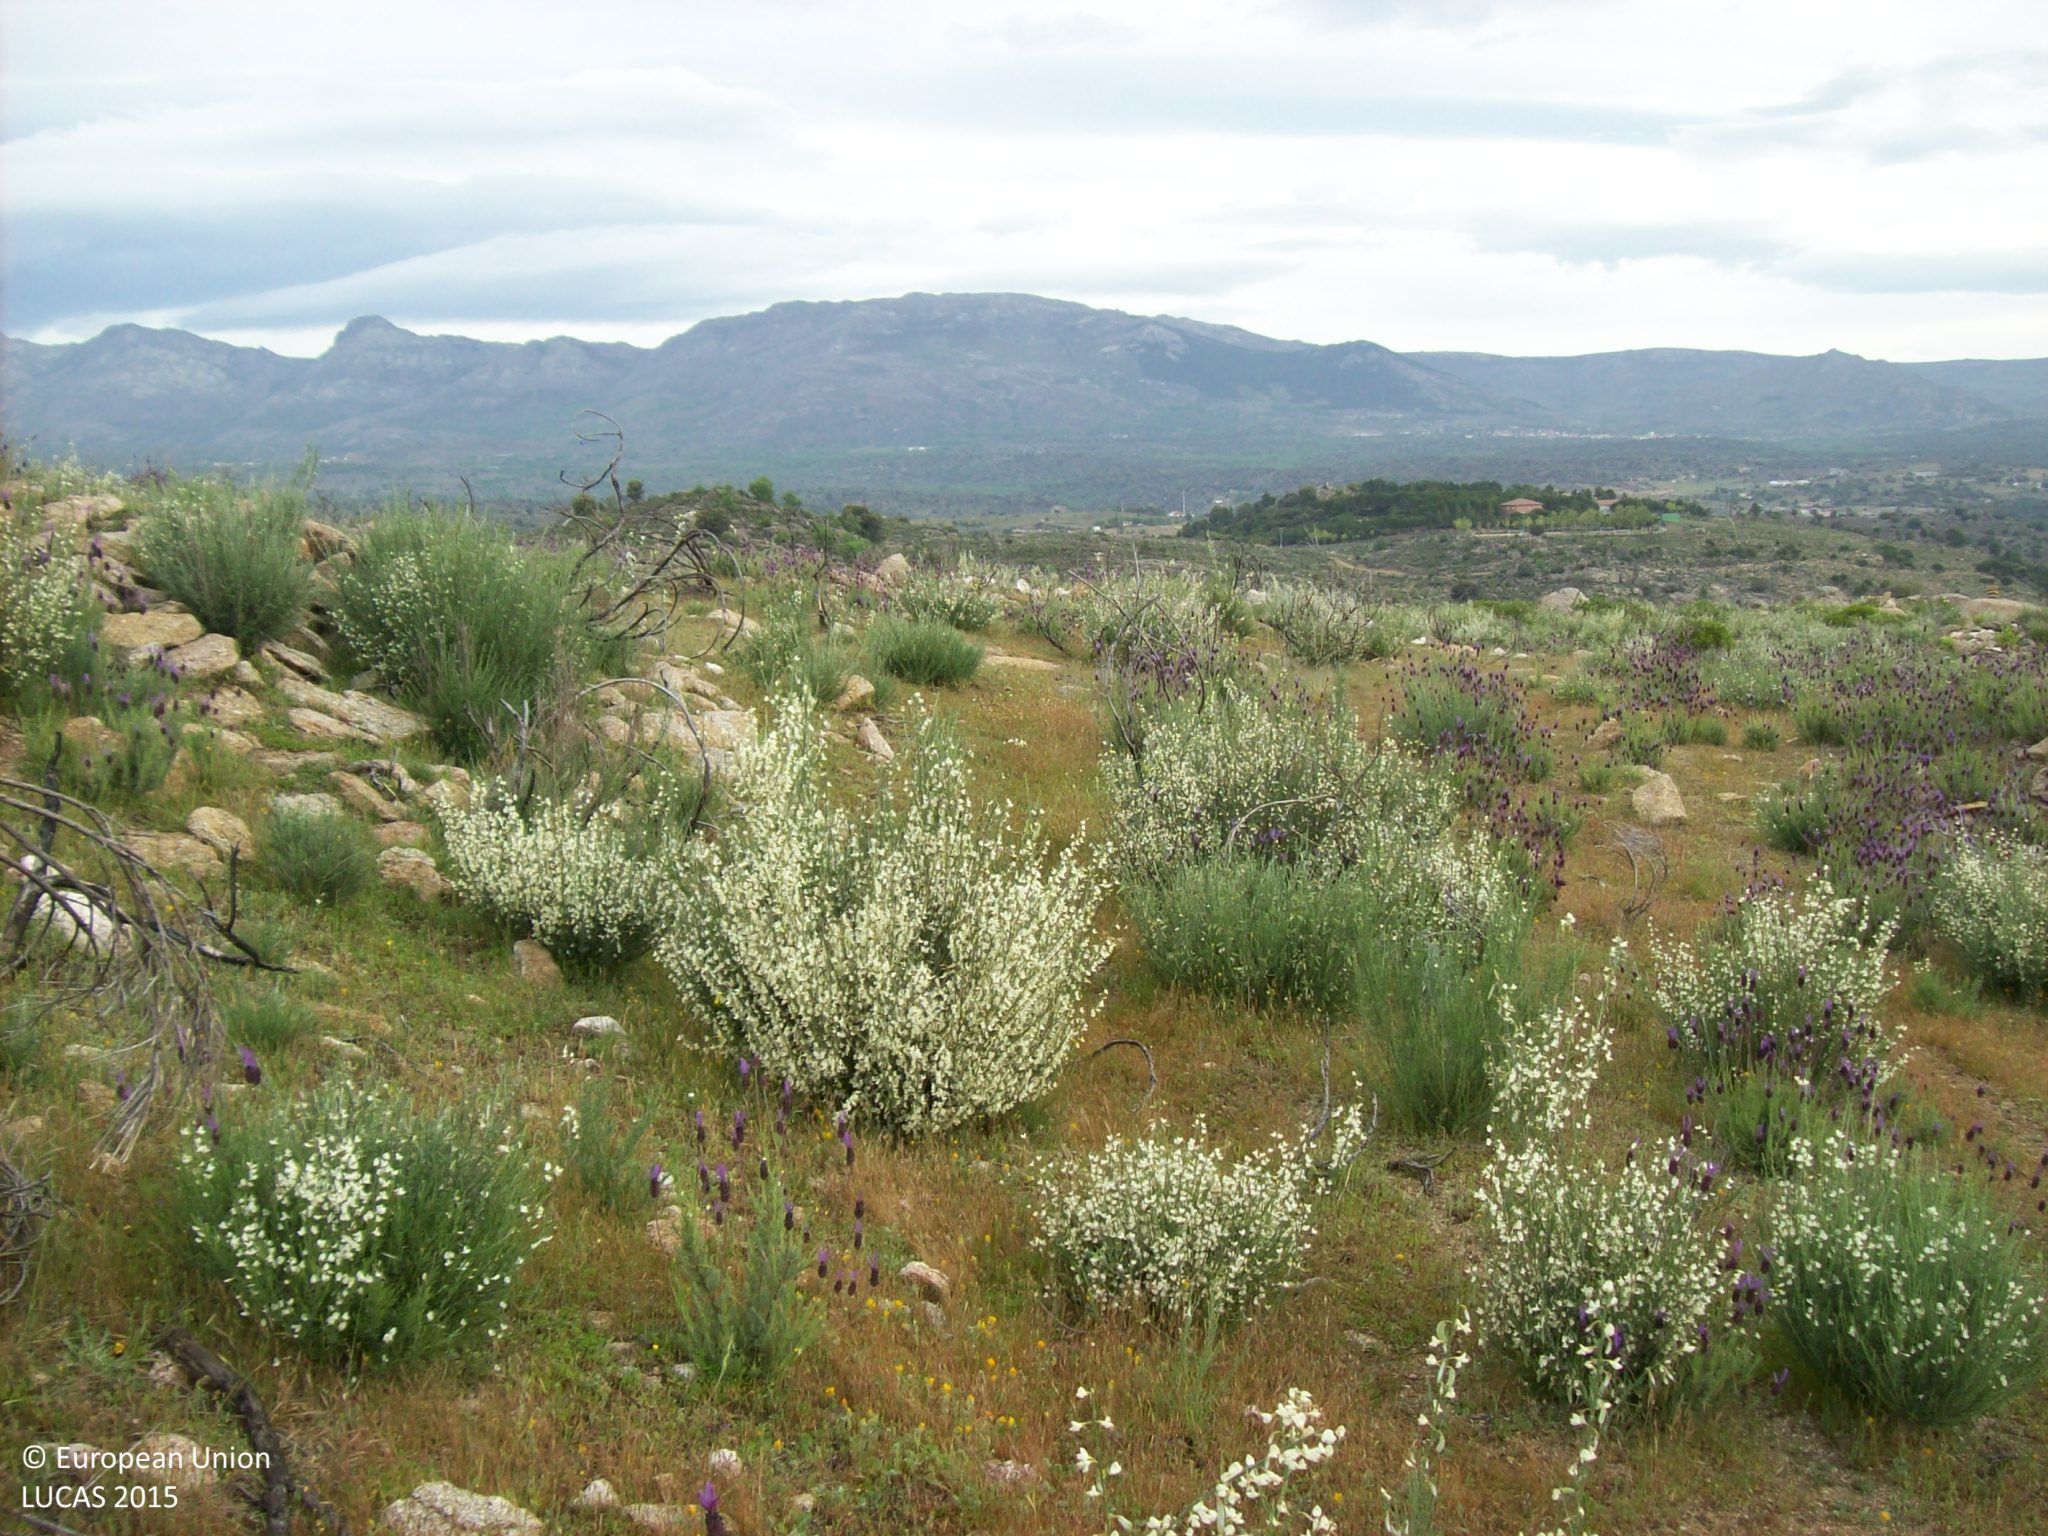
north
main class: Shrubland
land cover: Shrubland without tree cover
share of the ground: 25 - 50 %
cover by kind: herbaceous plants 45 %, shrubs 40 %, consolidated bare surface 10 %
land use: Agriculture (excluding fallow land and kitchen gardens)
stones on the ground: < 10 %
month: May
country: ES
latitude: 40.3876
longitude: -4.7902
